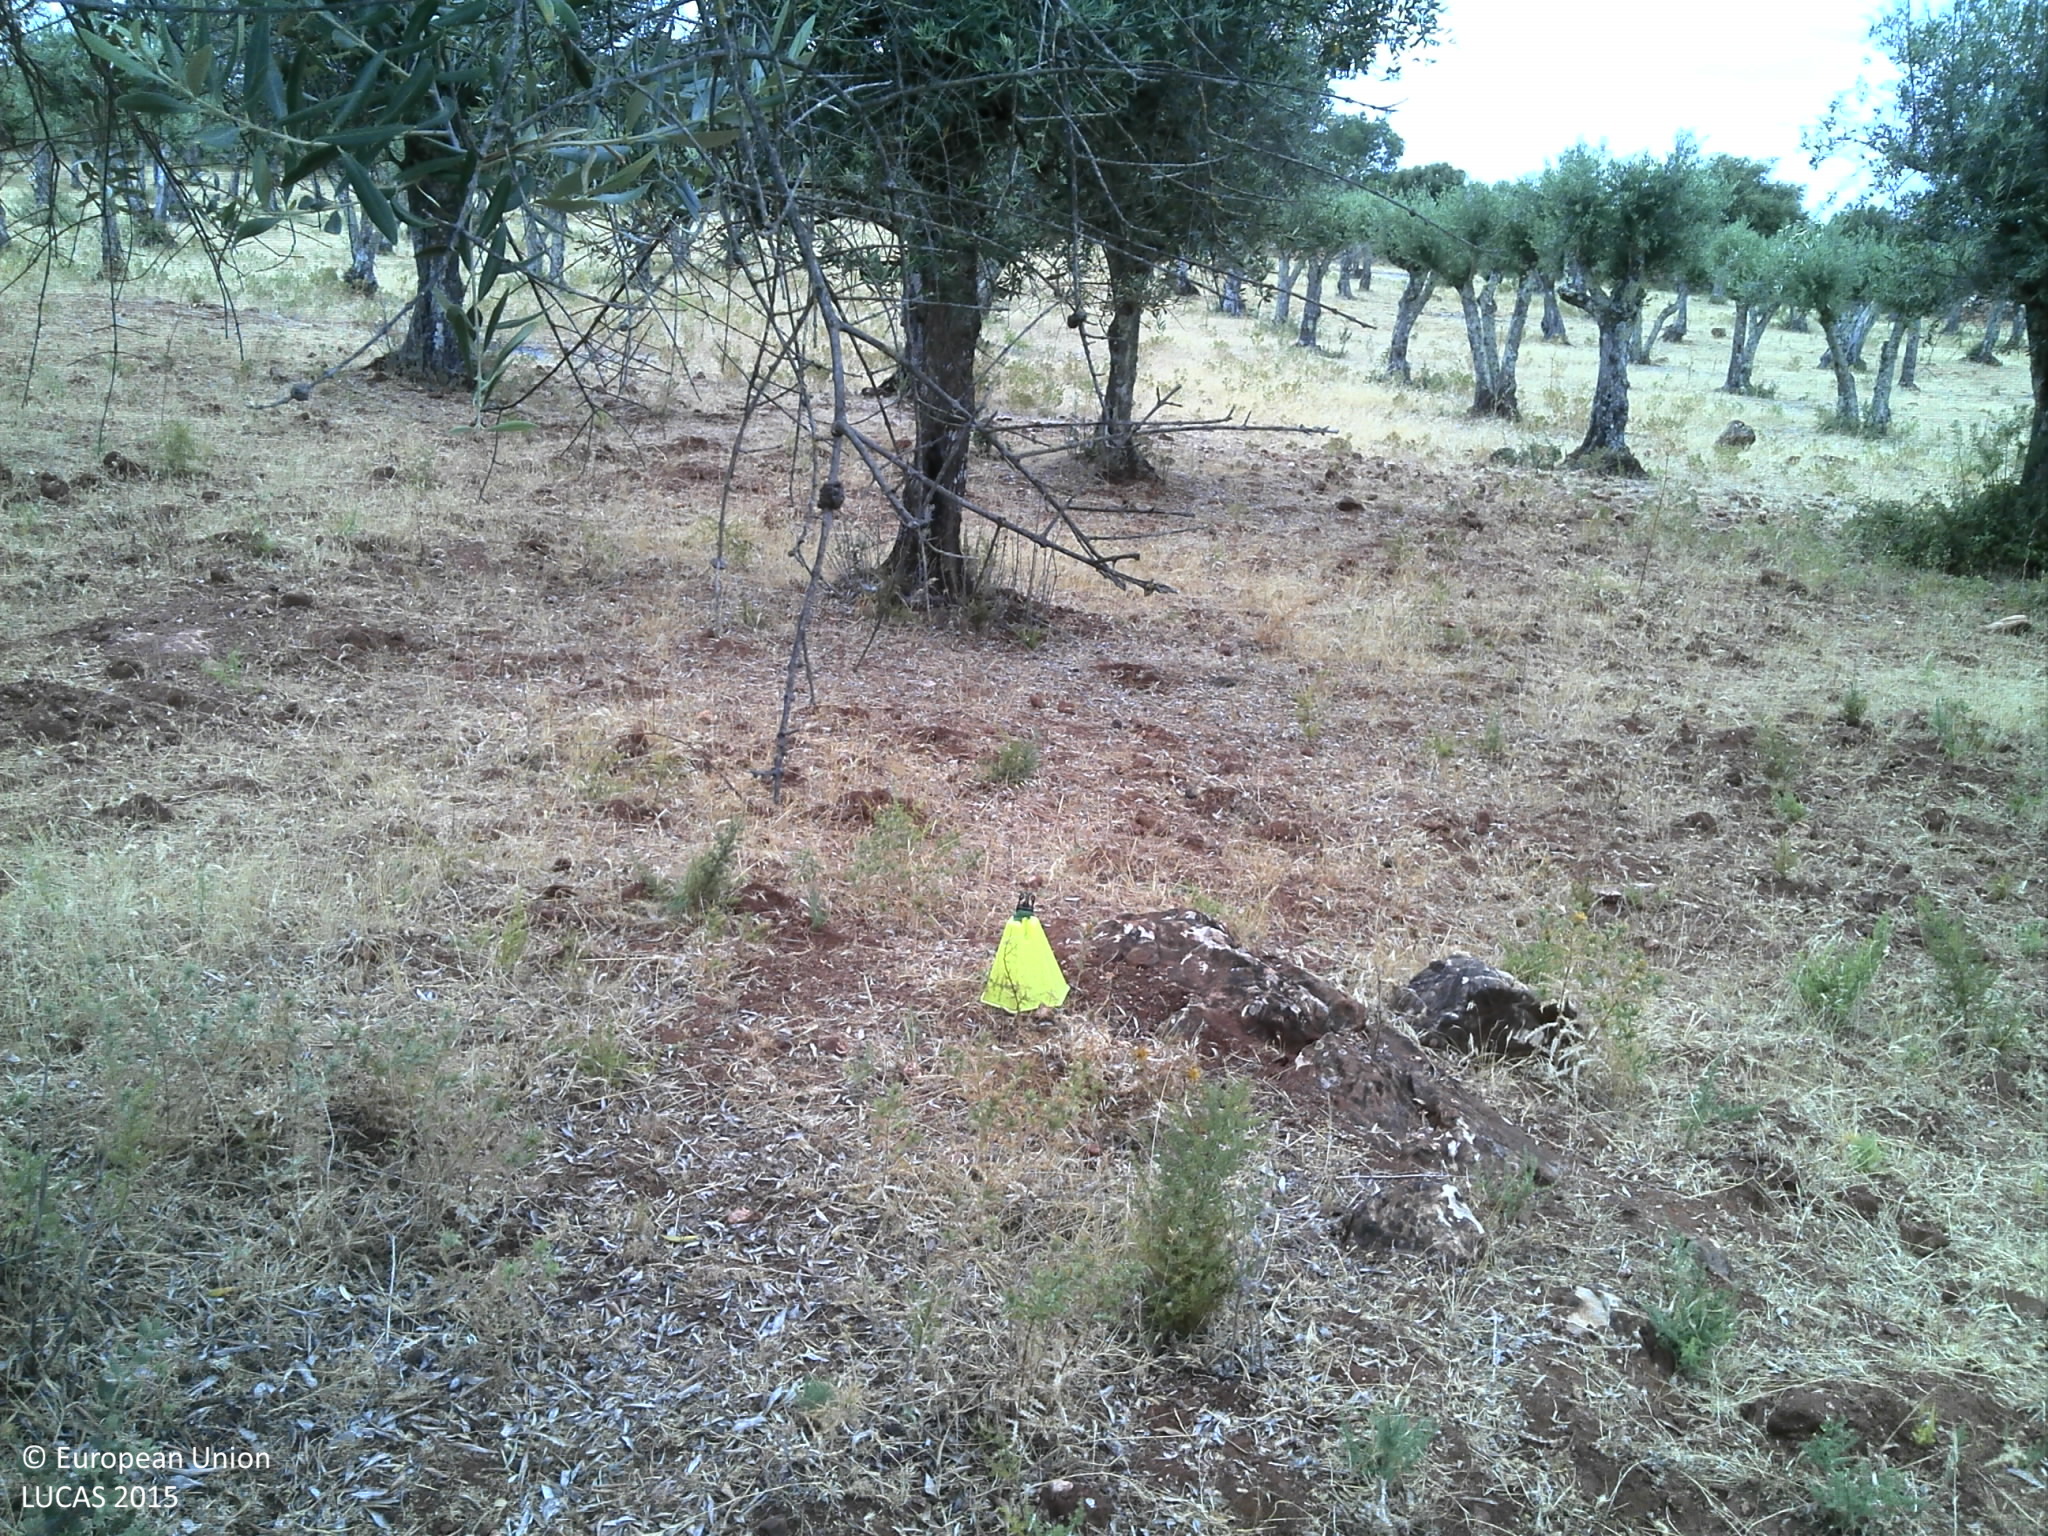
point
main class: Cropland
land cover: Olive groves
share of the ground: 25 - 50 %
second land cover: Grassland without tree/shrub cover
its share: 25 - 50 %
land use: Agriculture (excluding fallow land and kitchen gardens)
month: July
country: PT
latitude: 38.7915
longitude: -7.4991
